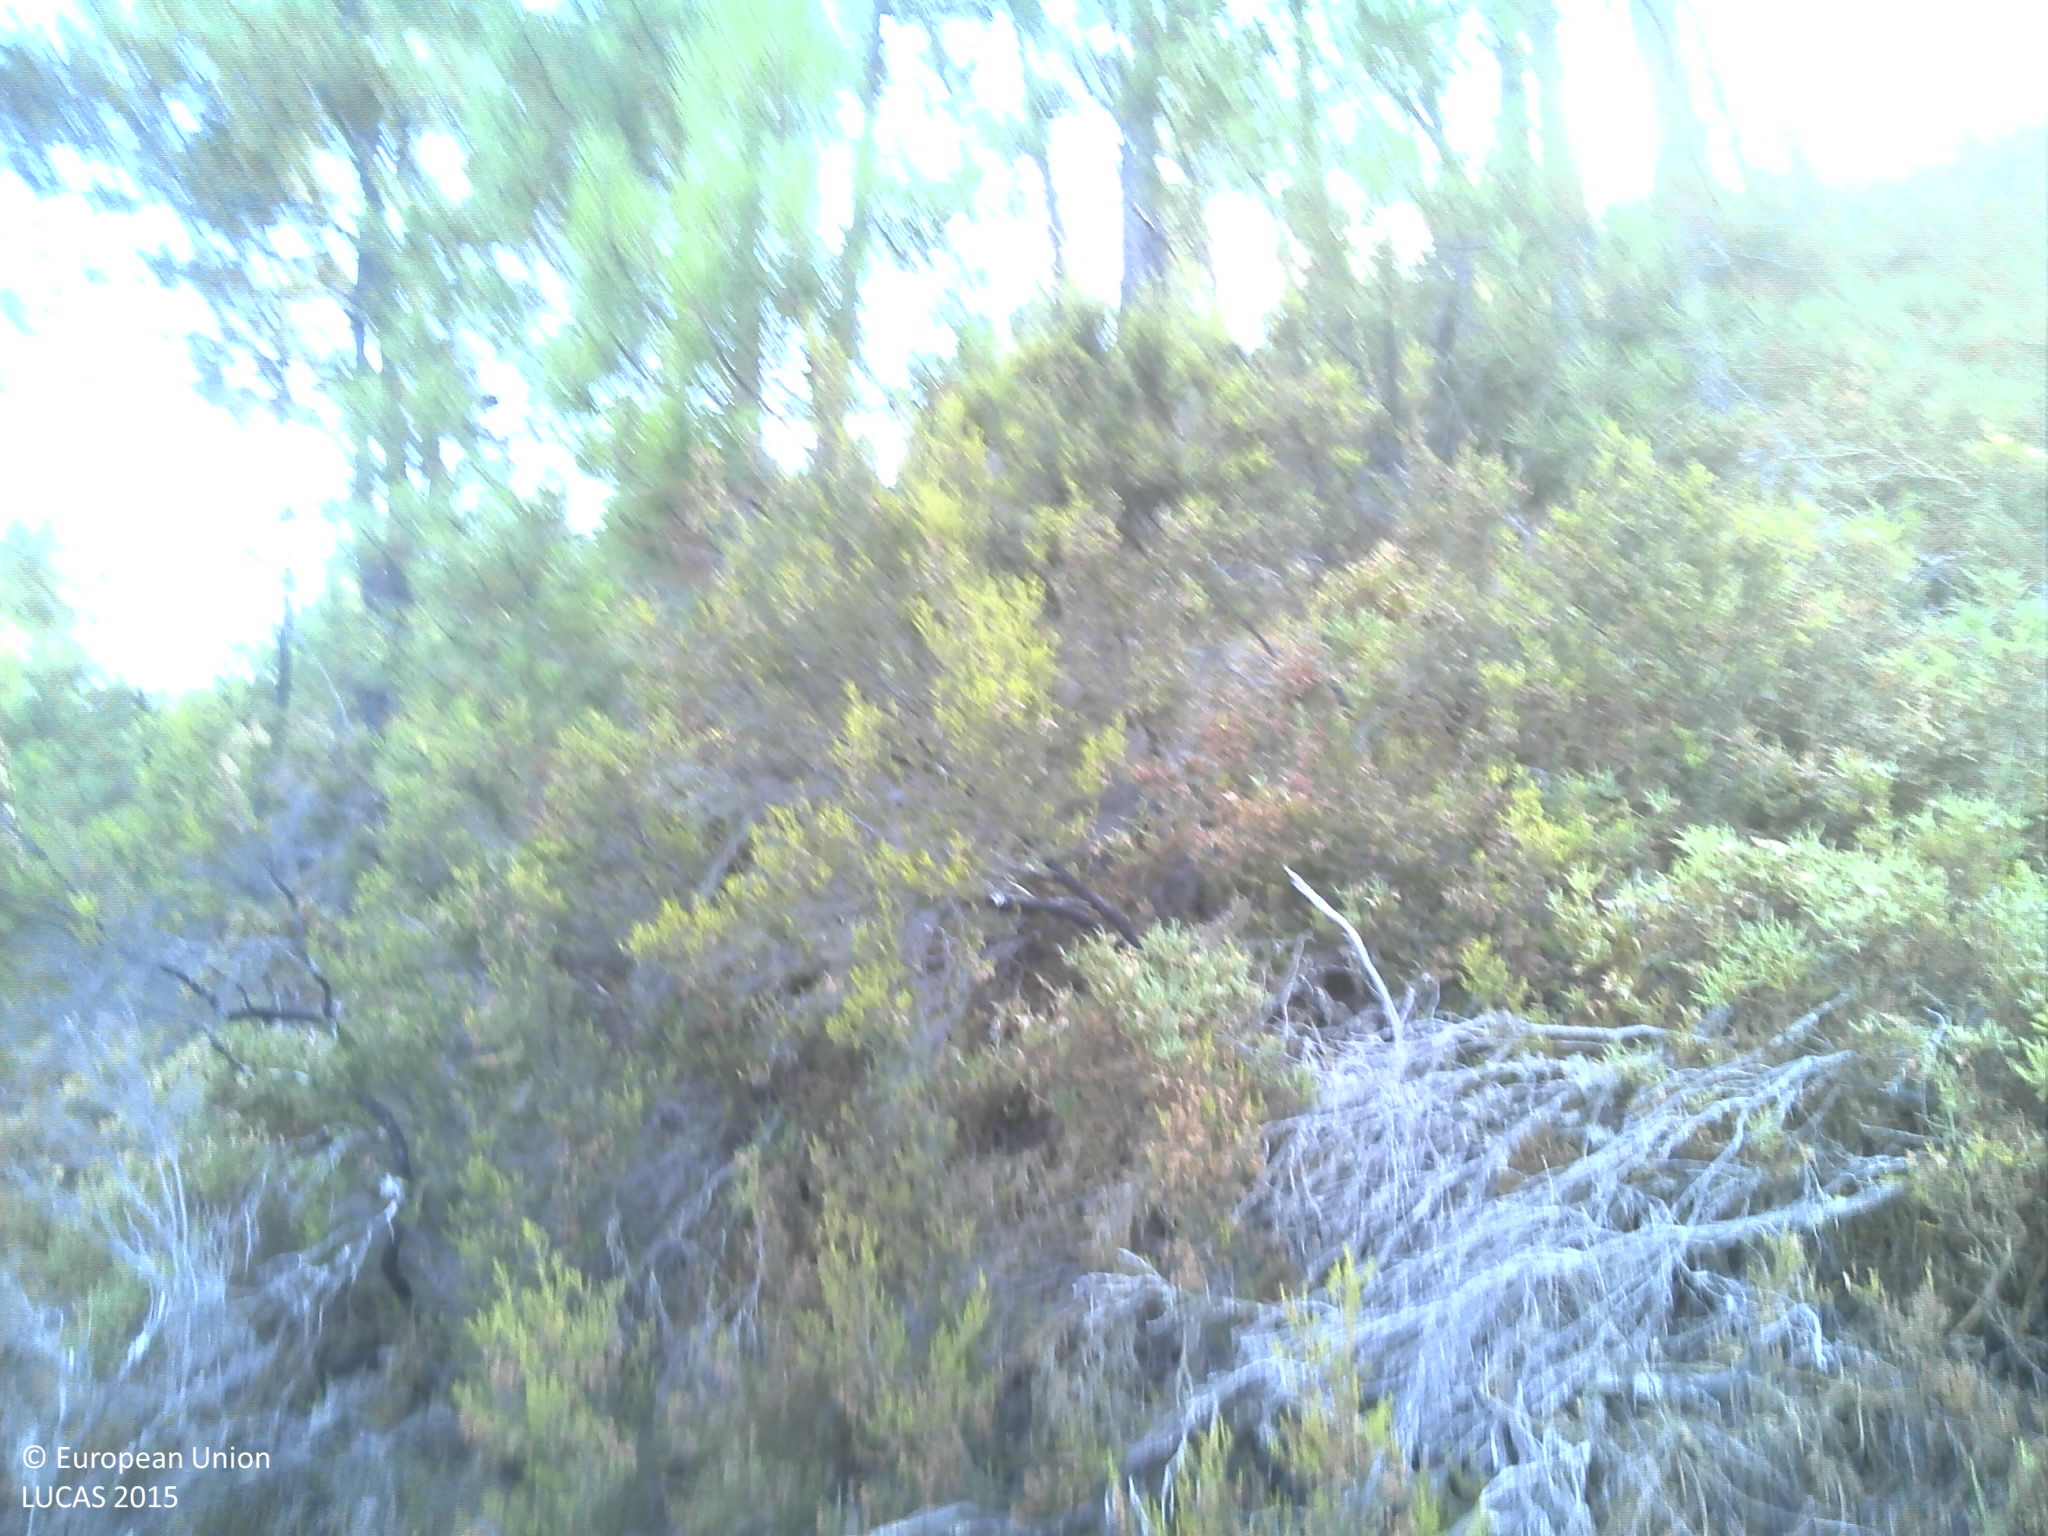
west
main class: Shrubland
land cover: Shrubland with sparse tree cover
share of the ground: 25 - 50 %
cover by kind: unconsolidated bare surface 55 %, shrubs 30 %, herbaceous plants 10 %, coniferous forest trees 5 %
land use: Abandoned areas
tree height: < 5 m
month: July
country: PT
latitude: 40.1568
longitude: -7.8052
